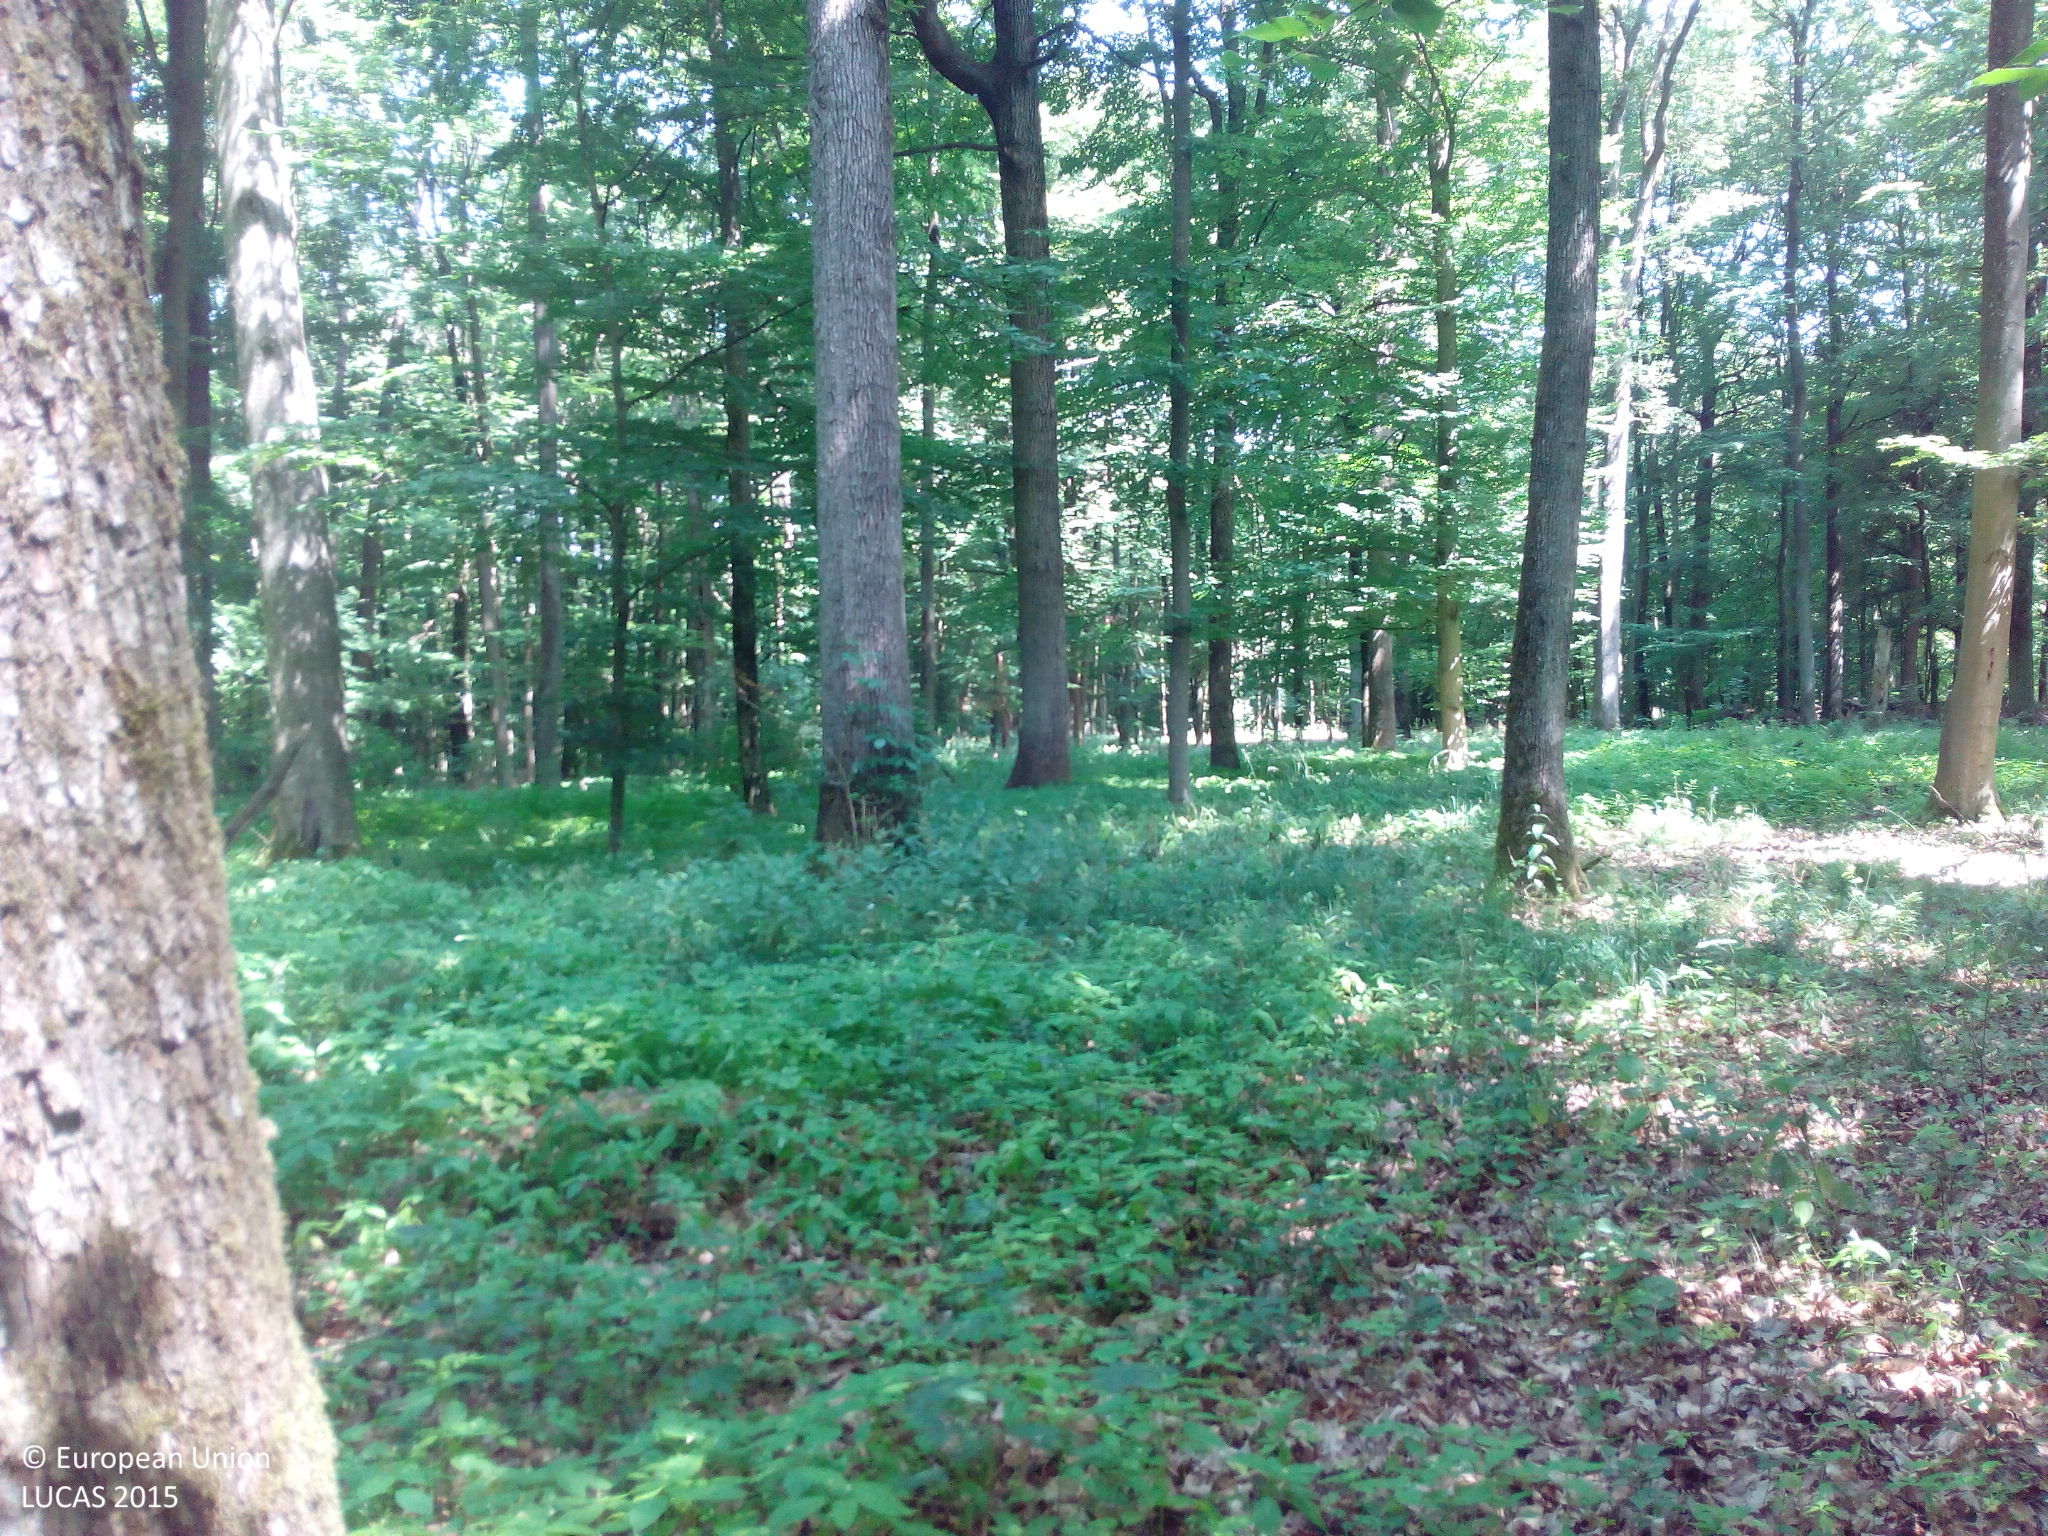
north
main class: Woodland
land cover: Broadleaved woodland
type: mesophytic deciduous forest
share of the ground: > 75 %
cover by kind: broadleaved forest trees 90 %, herbaceous plants 10 %
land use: Forestry
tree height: > 5 m
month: July
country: DE
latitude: 49.5368
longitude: 9.9309
